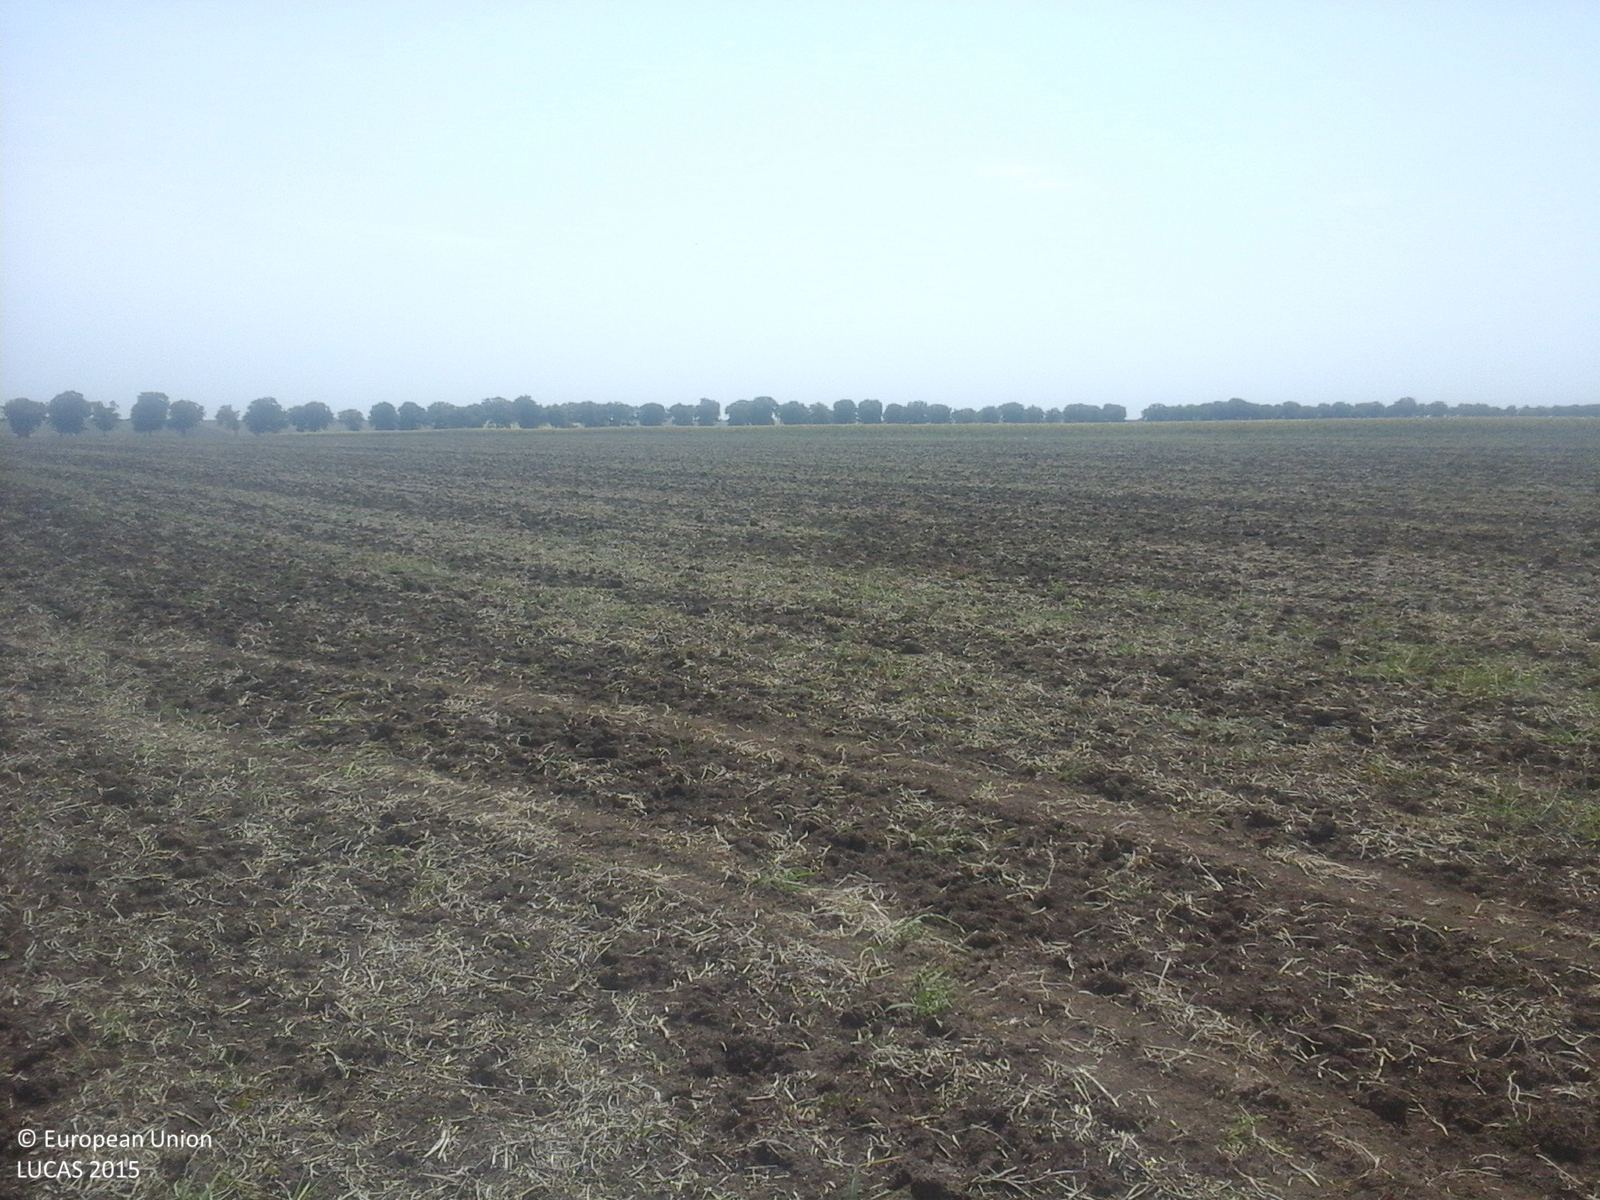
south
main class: Cropland
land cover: Soya
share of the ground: < 10 %
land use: Agriculture (excluding fallow land and kitchen gardens)
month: August
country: RO
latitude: 43.8882
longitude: 28.2956
